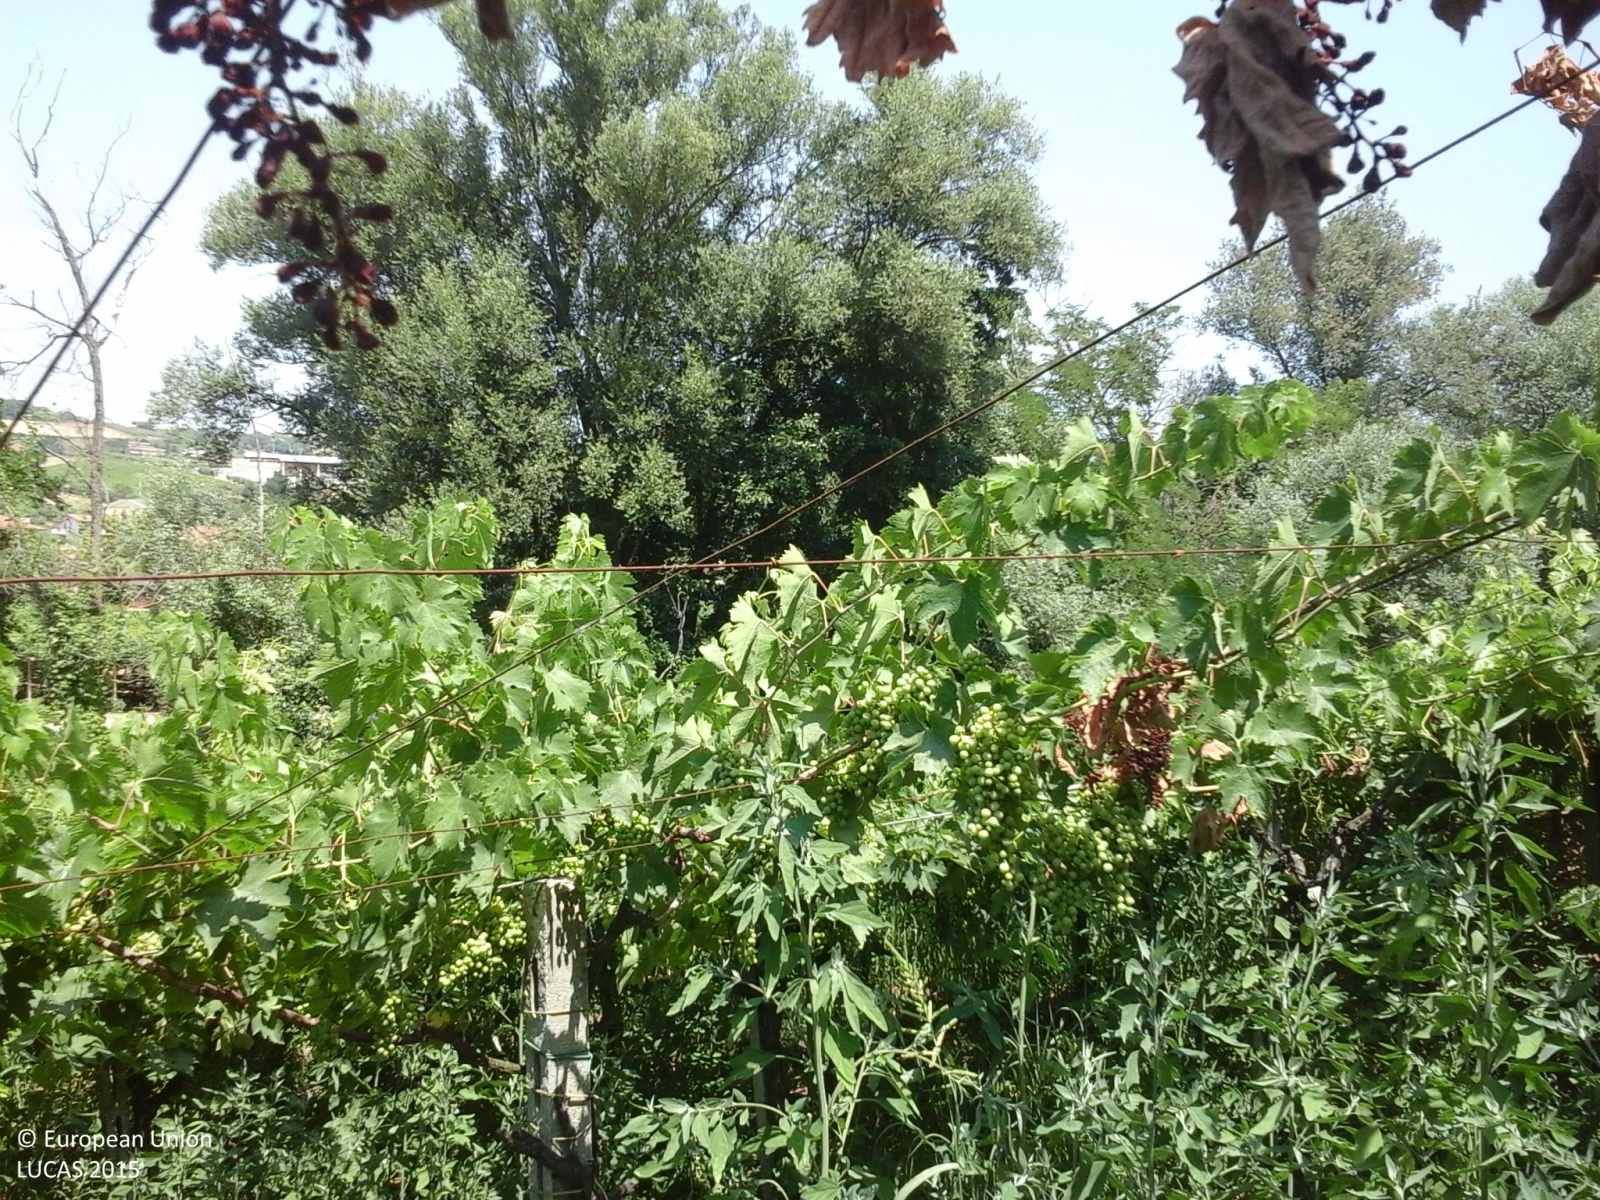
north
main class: Cropland
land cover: Vineyards
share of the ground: 25 - 50 %
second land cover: Spontaneously vegetated surfaces
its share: 25 - 50 %
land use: Agriculture (excluding fallow land and kitchen gardens)
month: July
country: IT
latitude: 42.3118
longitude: 14.2455
